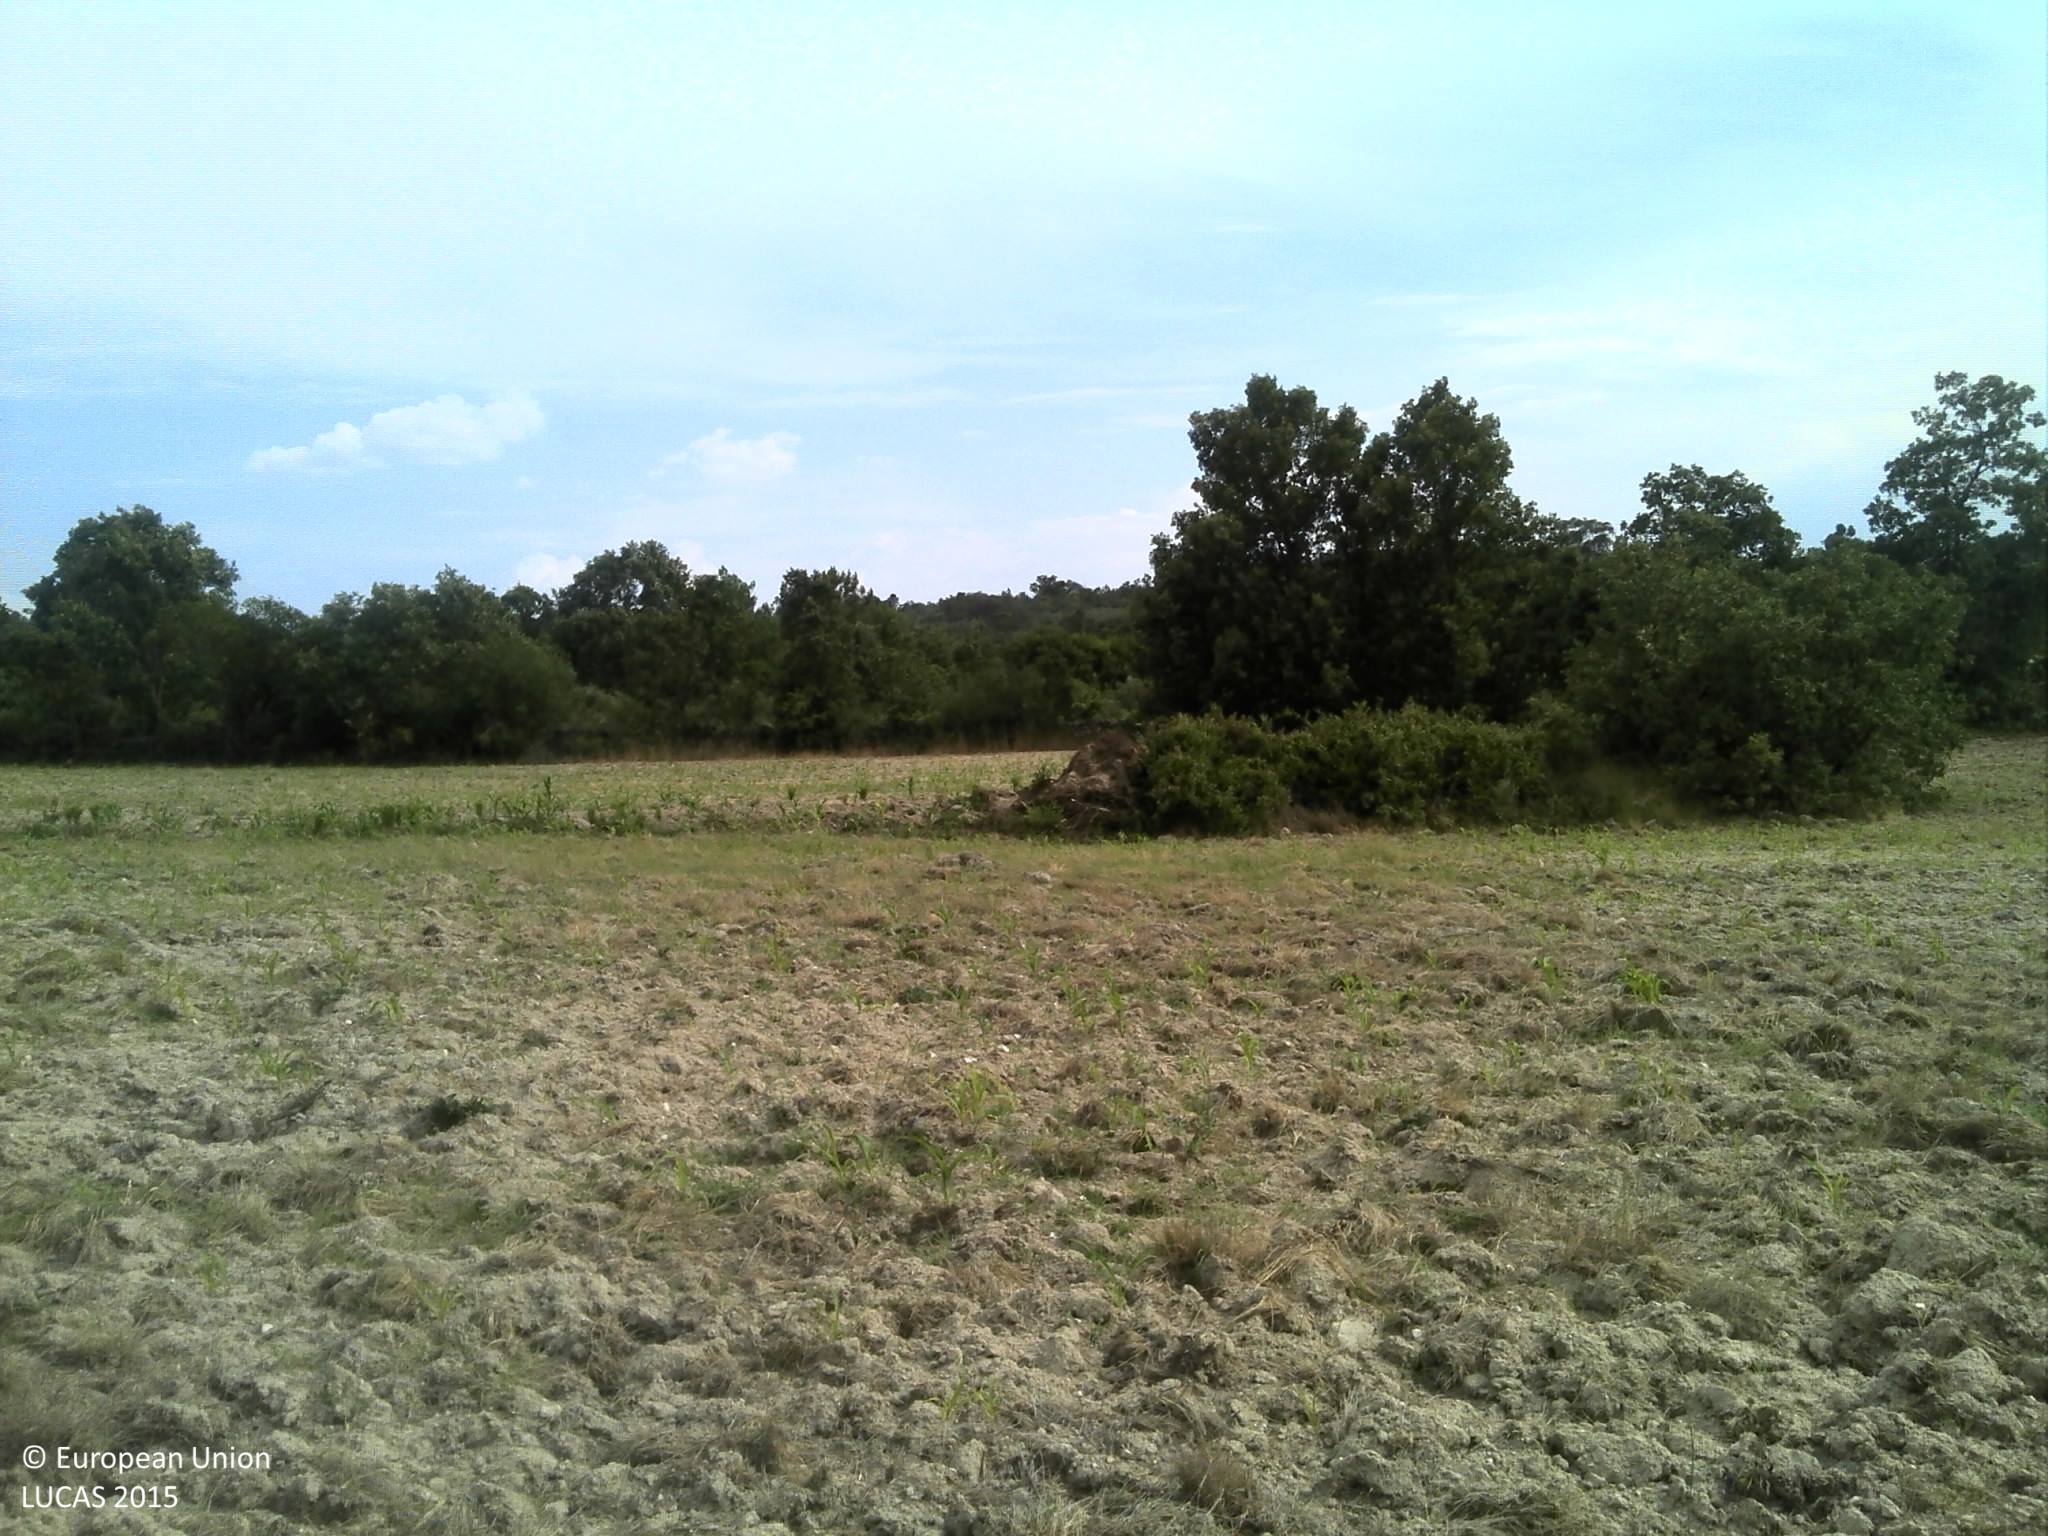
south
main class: Cropland
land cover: Maize
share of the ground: < 10 %
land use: Agriculture (excluding fallow land and kitchen gardens)
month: June
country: PT
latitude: 40.2712
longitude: -7.3794
